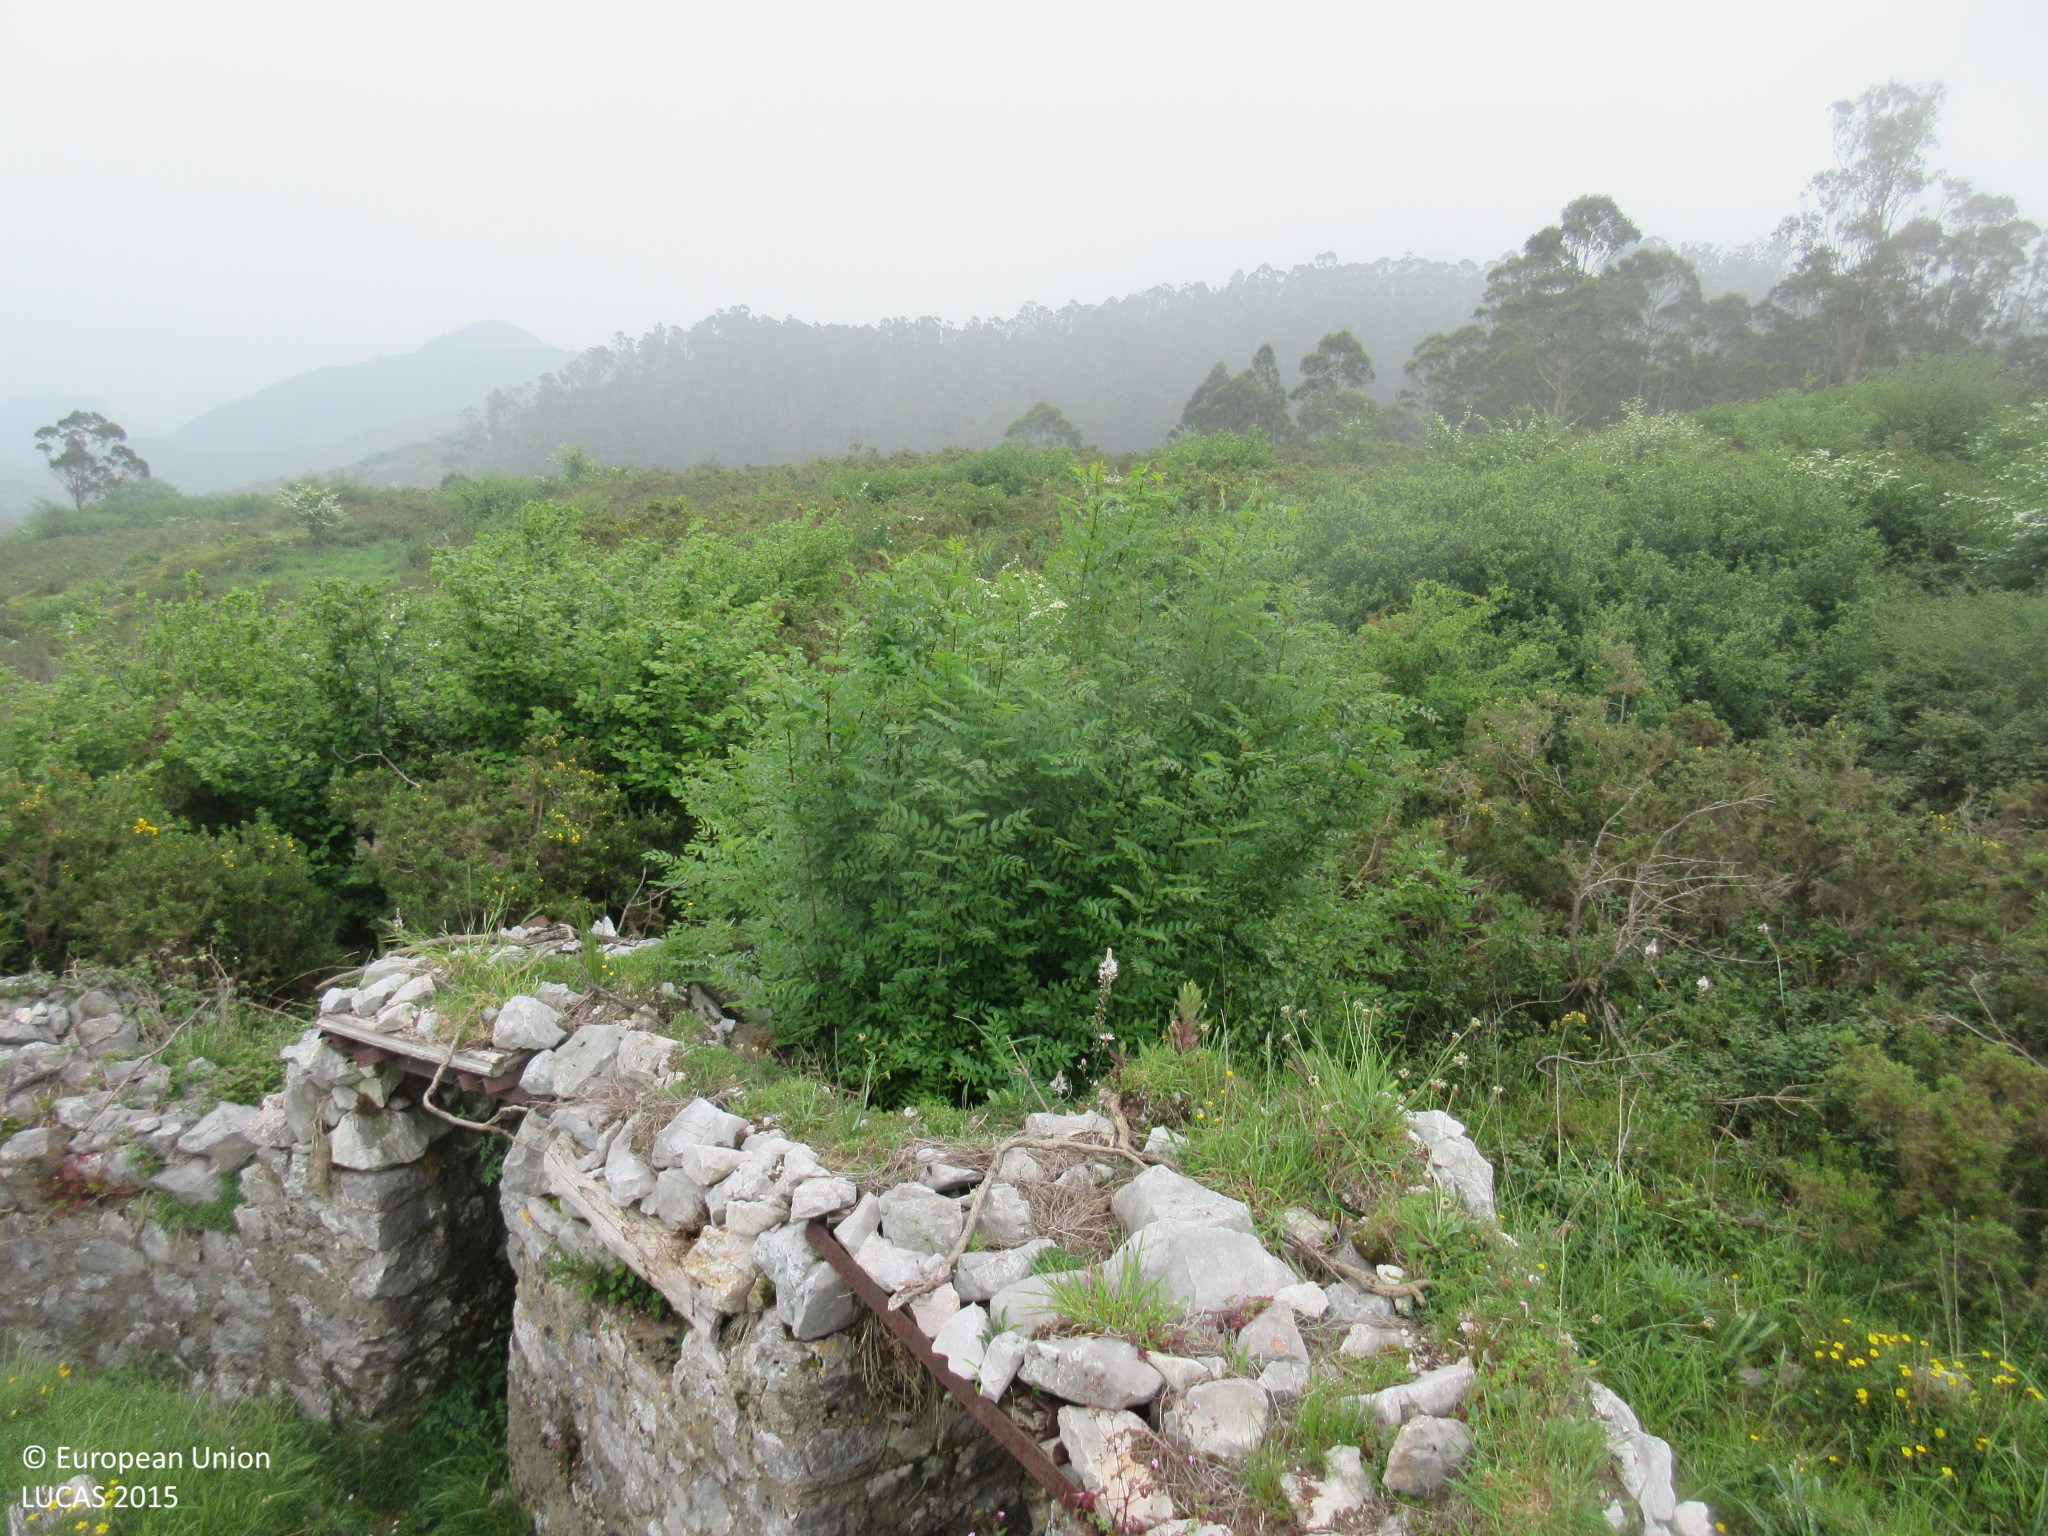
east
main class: Shrubland
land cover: Shrubland with sparse tree cover
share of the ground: > 75 %
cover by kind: shrubs 95 %, broadleaved forest trees 5 %
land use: Semi-natural and natural areas not in use
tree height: > 5 m
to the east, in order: Shrubland with sparse tree cover; Broadleaved woodland; Shrubland with sparse tree cover; Broadleaved woodland
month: May
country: ES
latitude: 43.3938
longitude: -5.8791
